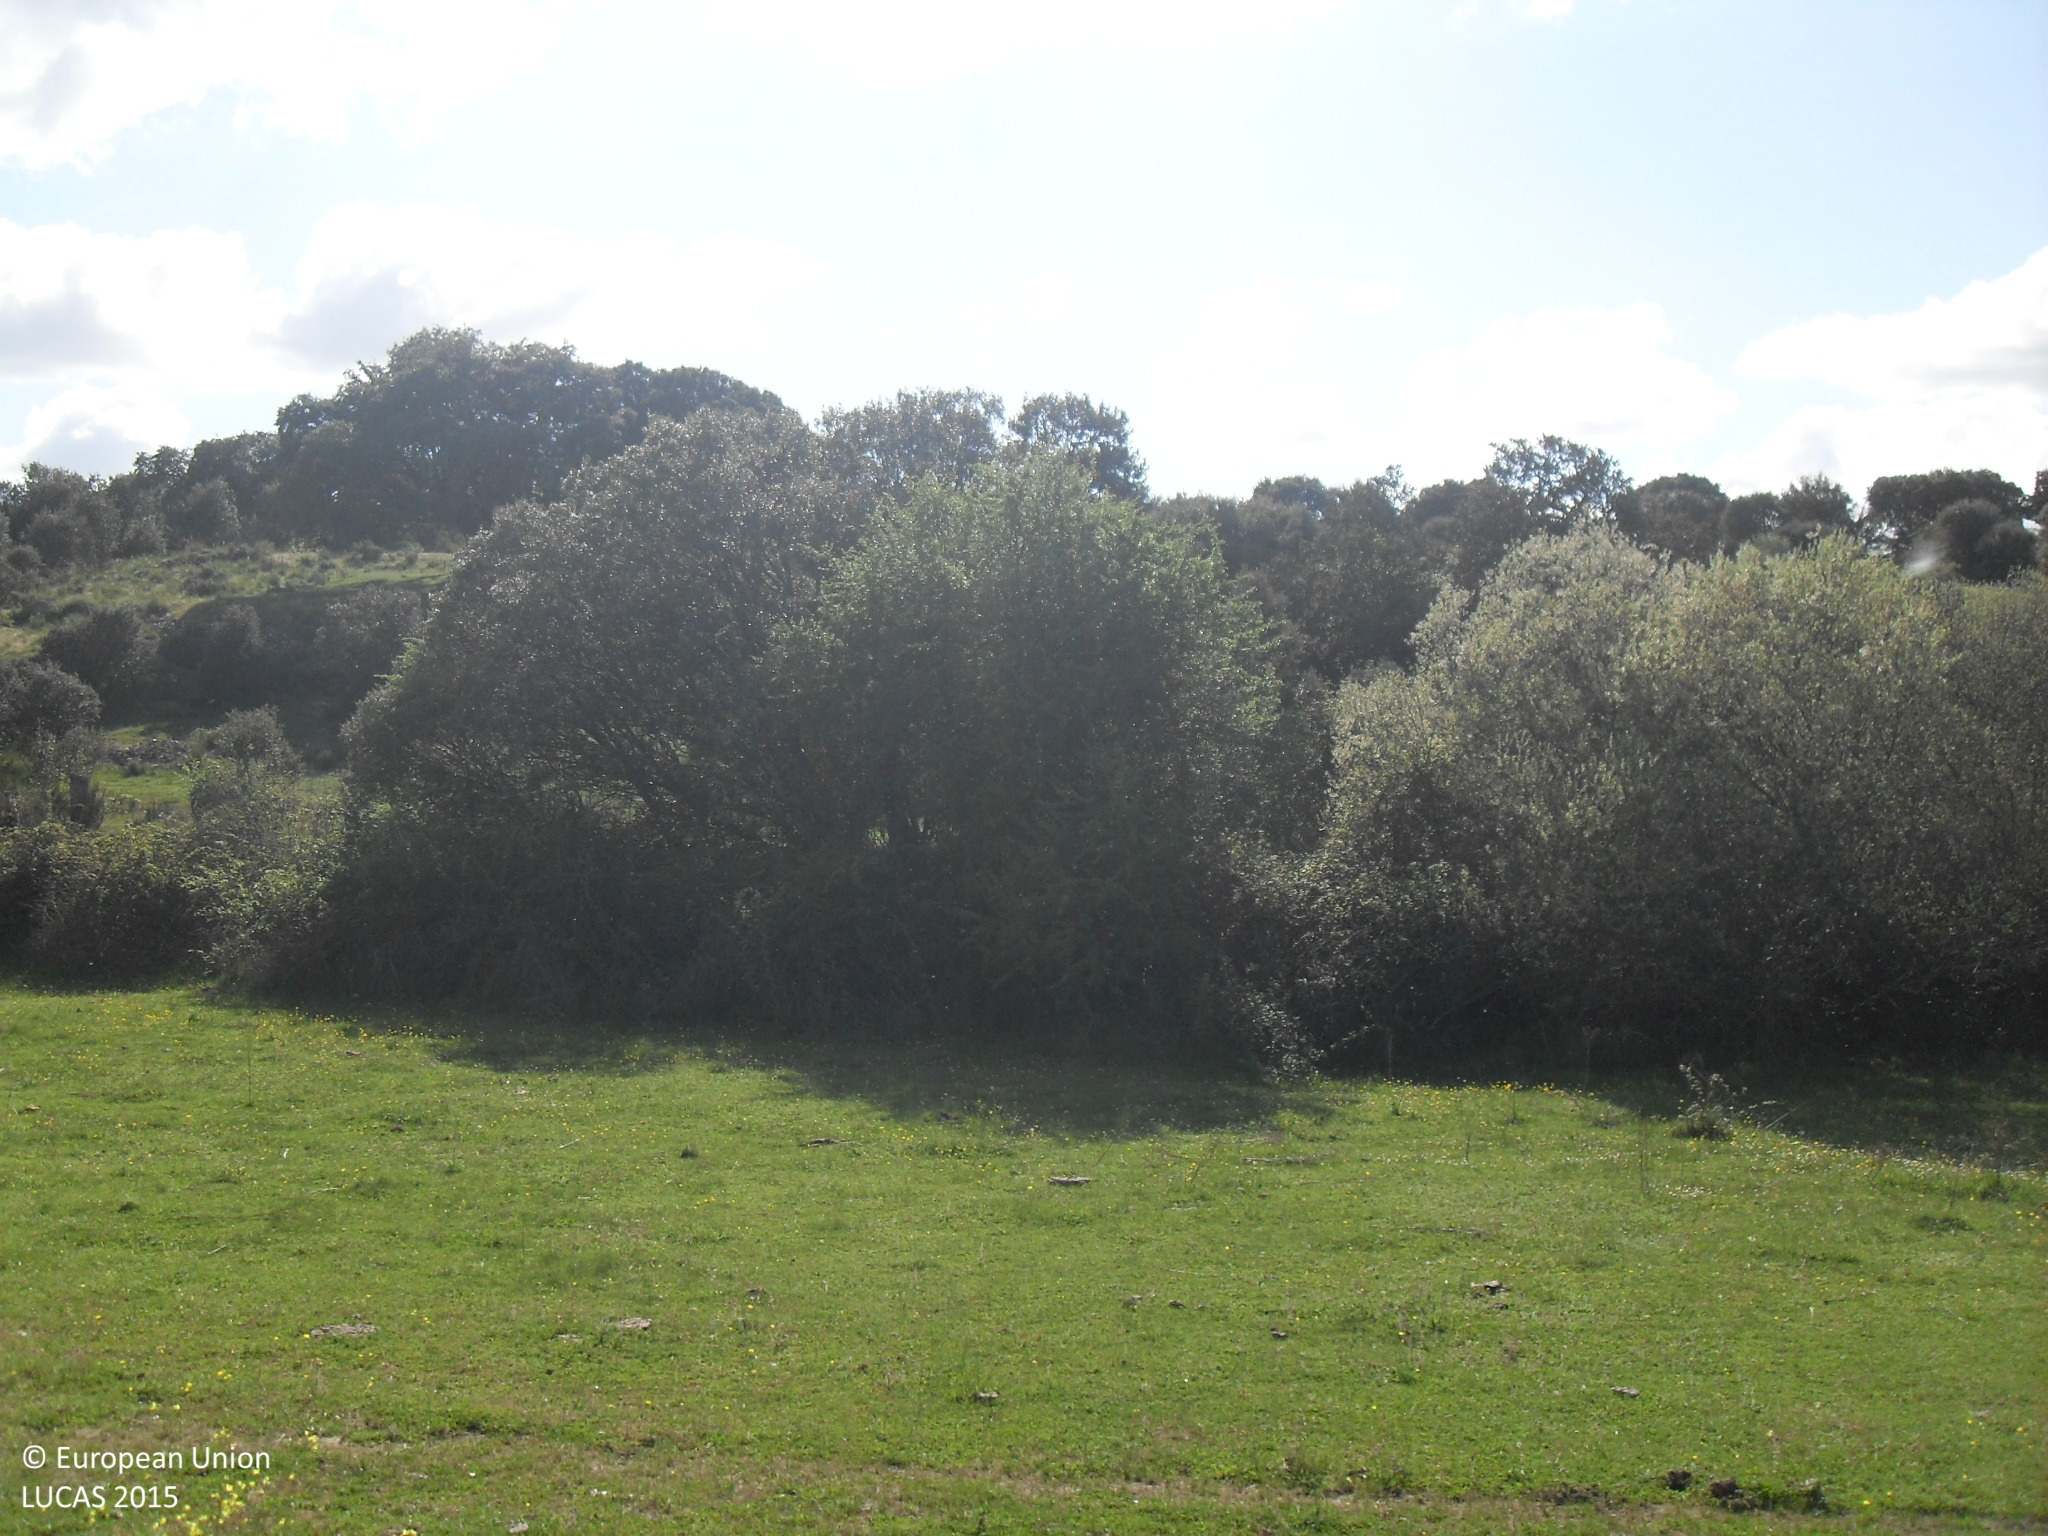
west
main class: Woodland
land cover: Broadleaved woodland
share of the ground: 10 - 25 %
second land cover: Grassland without tree/shrub cover
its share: > 75 %
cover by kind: herbaceous plants 85 %, broadleaved forest trees 15 %
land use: Forestry
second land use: Agriculture (excluding fallow land and kitchen gardens)
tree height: < 5 m
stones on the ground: < 10 %
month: May
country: ES
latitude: 40.6418
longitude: -5.2838
